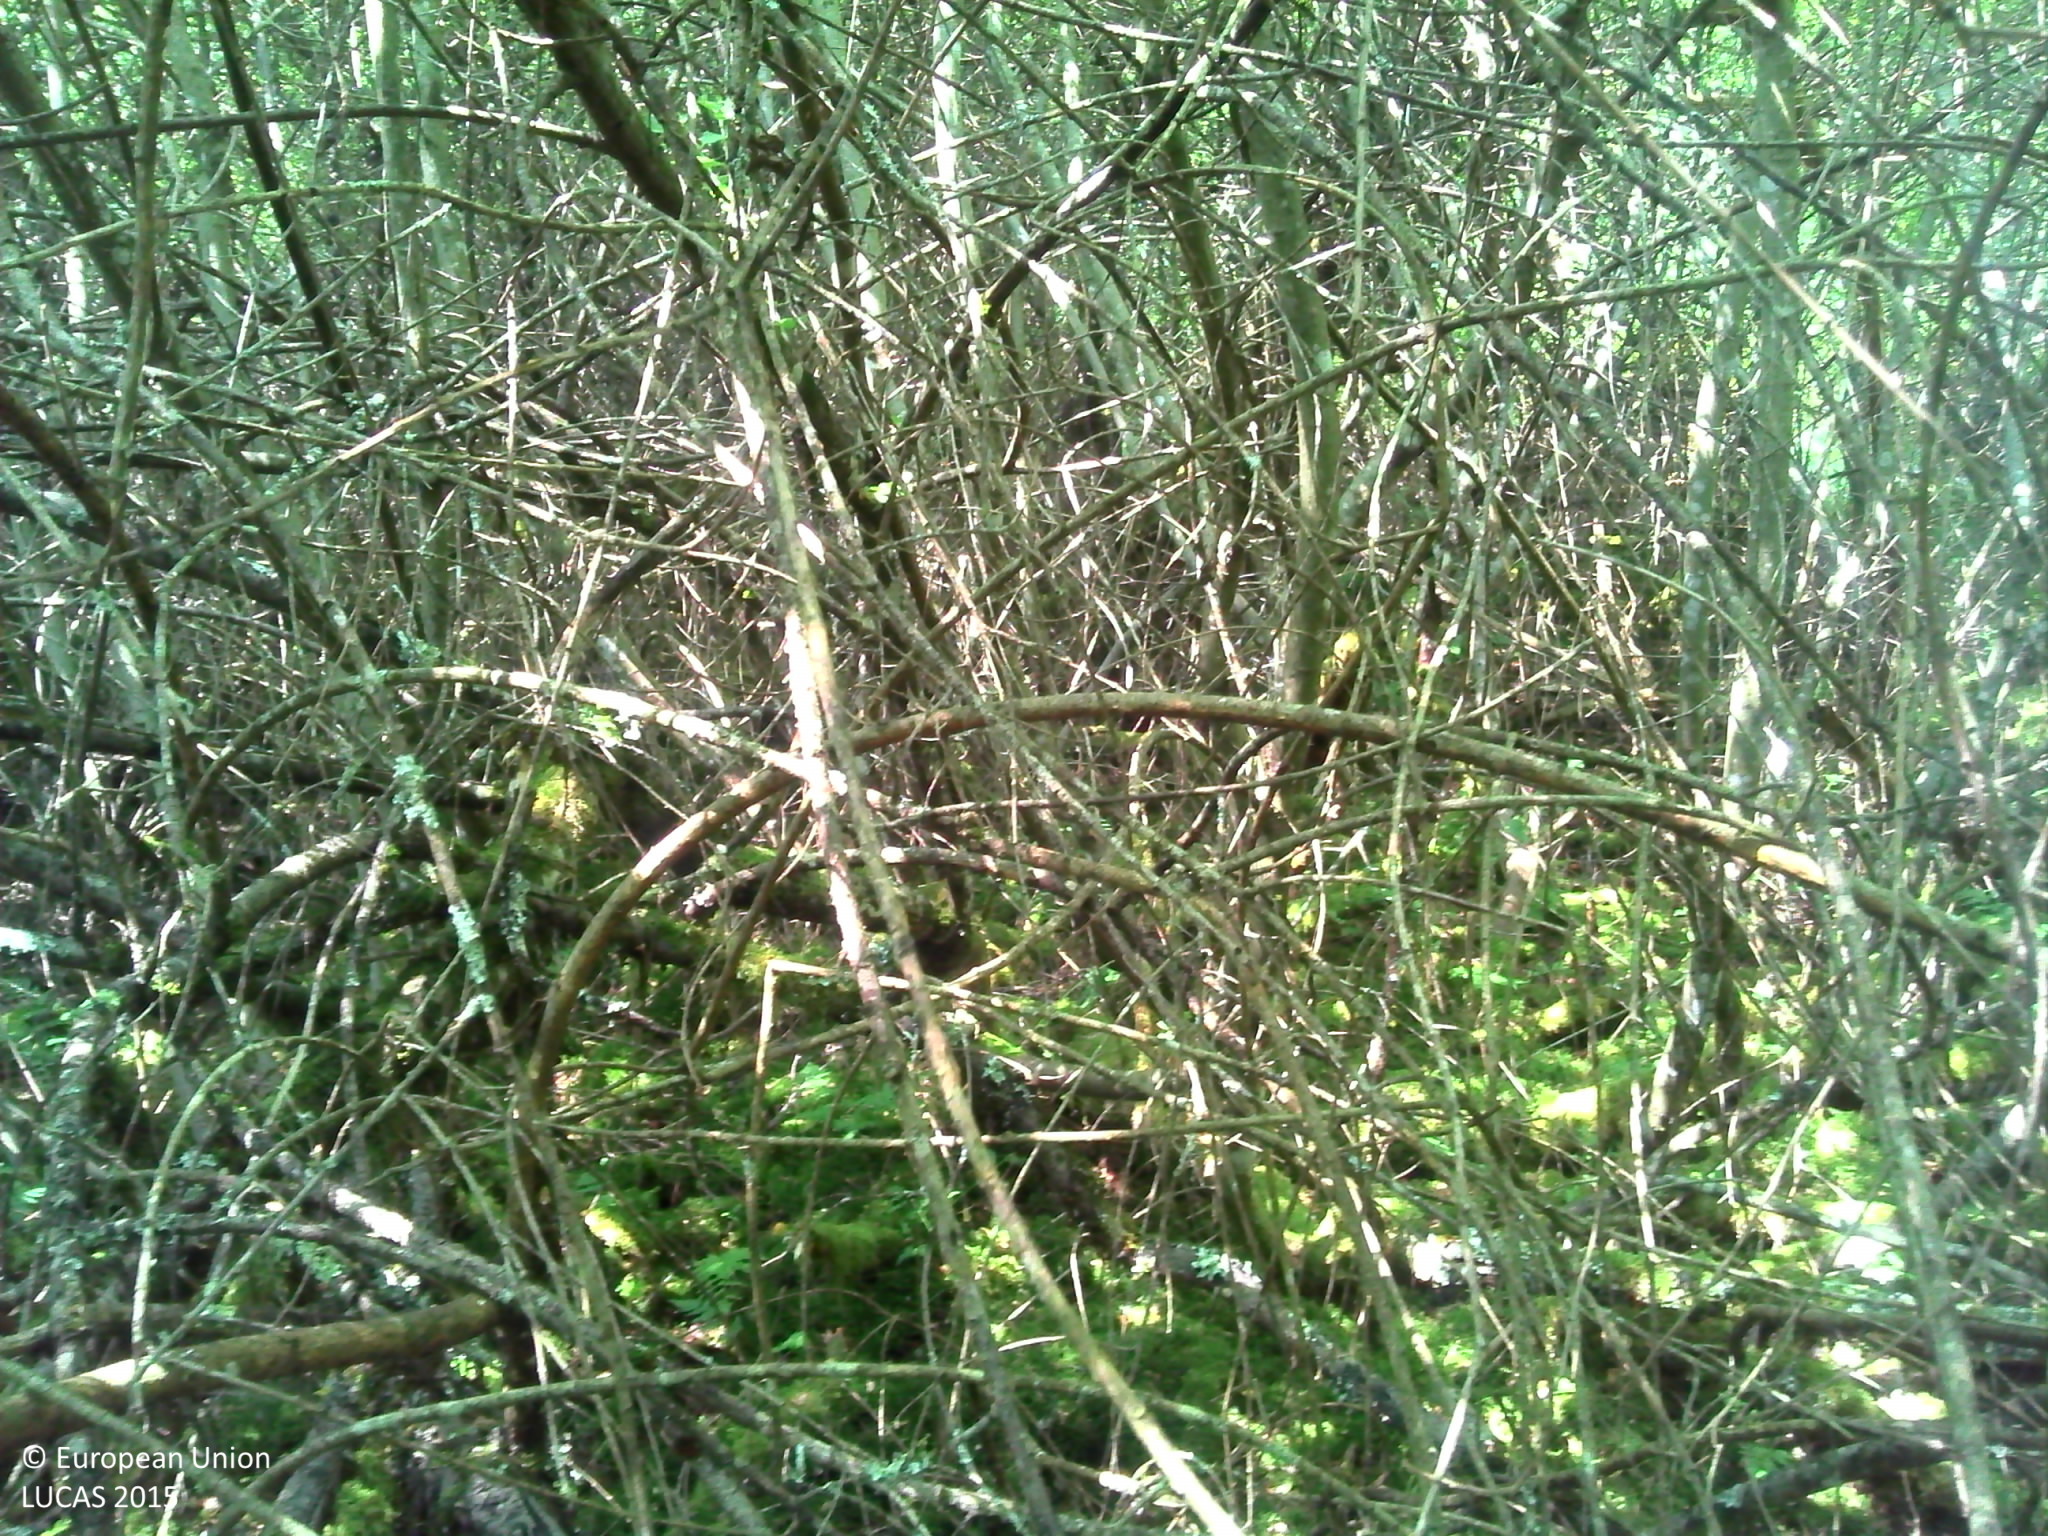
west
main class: Woodland
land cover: Broadleaved woodland
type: floodplain forest
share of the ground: > 75 %
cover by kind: broadleaved forest trees 60 %, lichens and mosses 20 %, shrubs 10 %, herbaceous plants 10 %
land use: Semi-natural and natural areas not in use
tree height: > 5 m
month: July
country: FR
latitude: 45.9814
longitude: 1.7967
